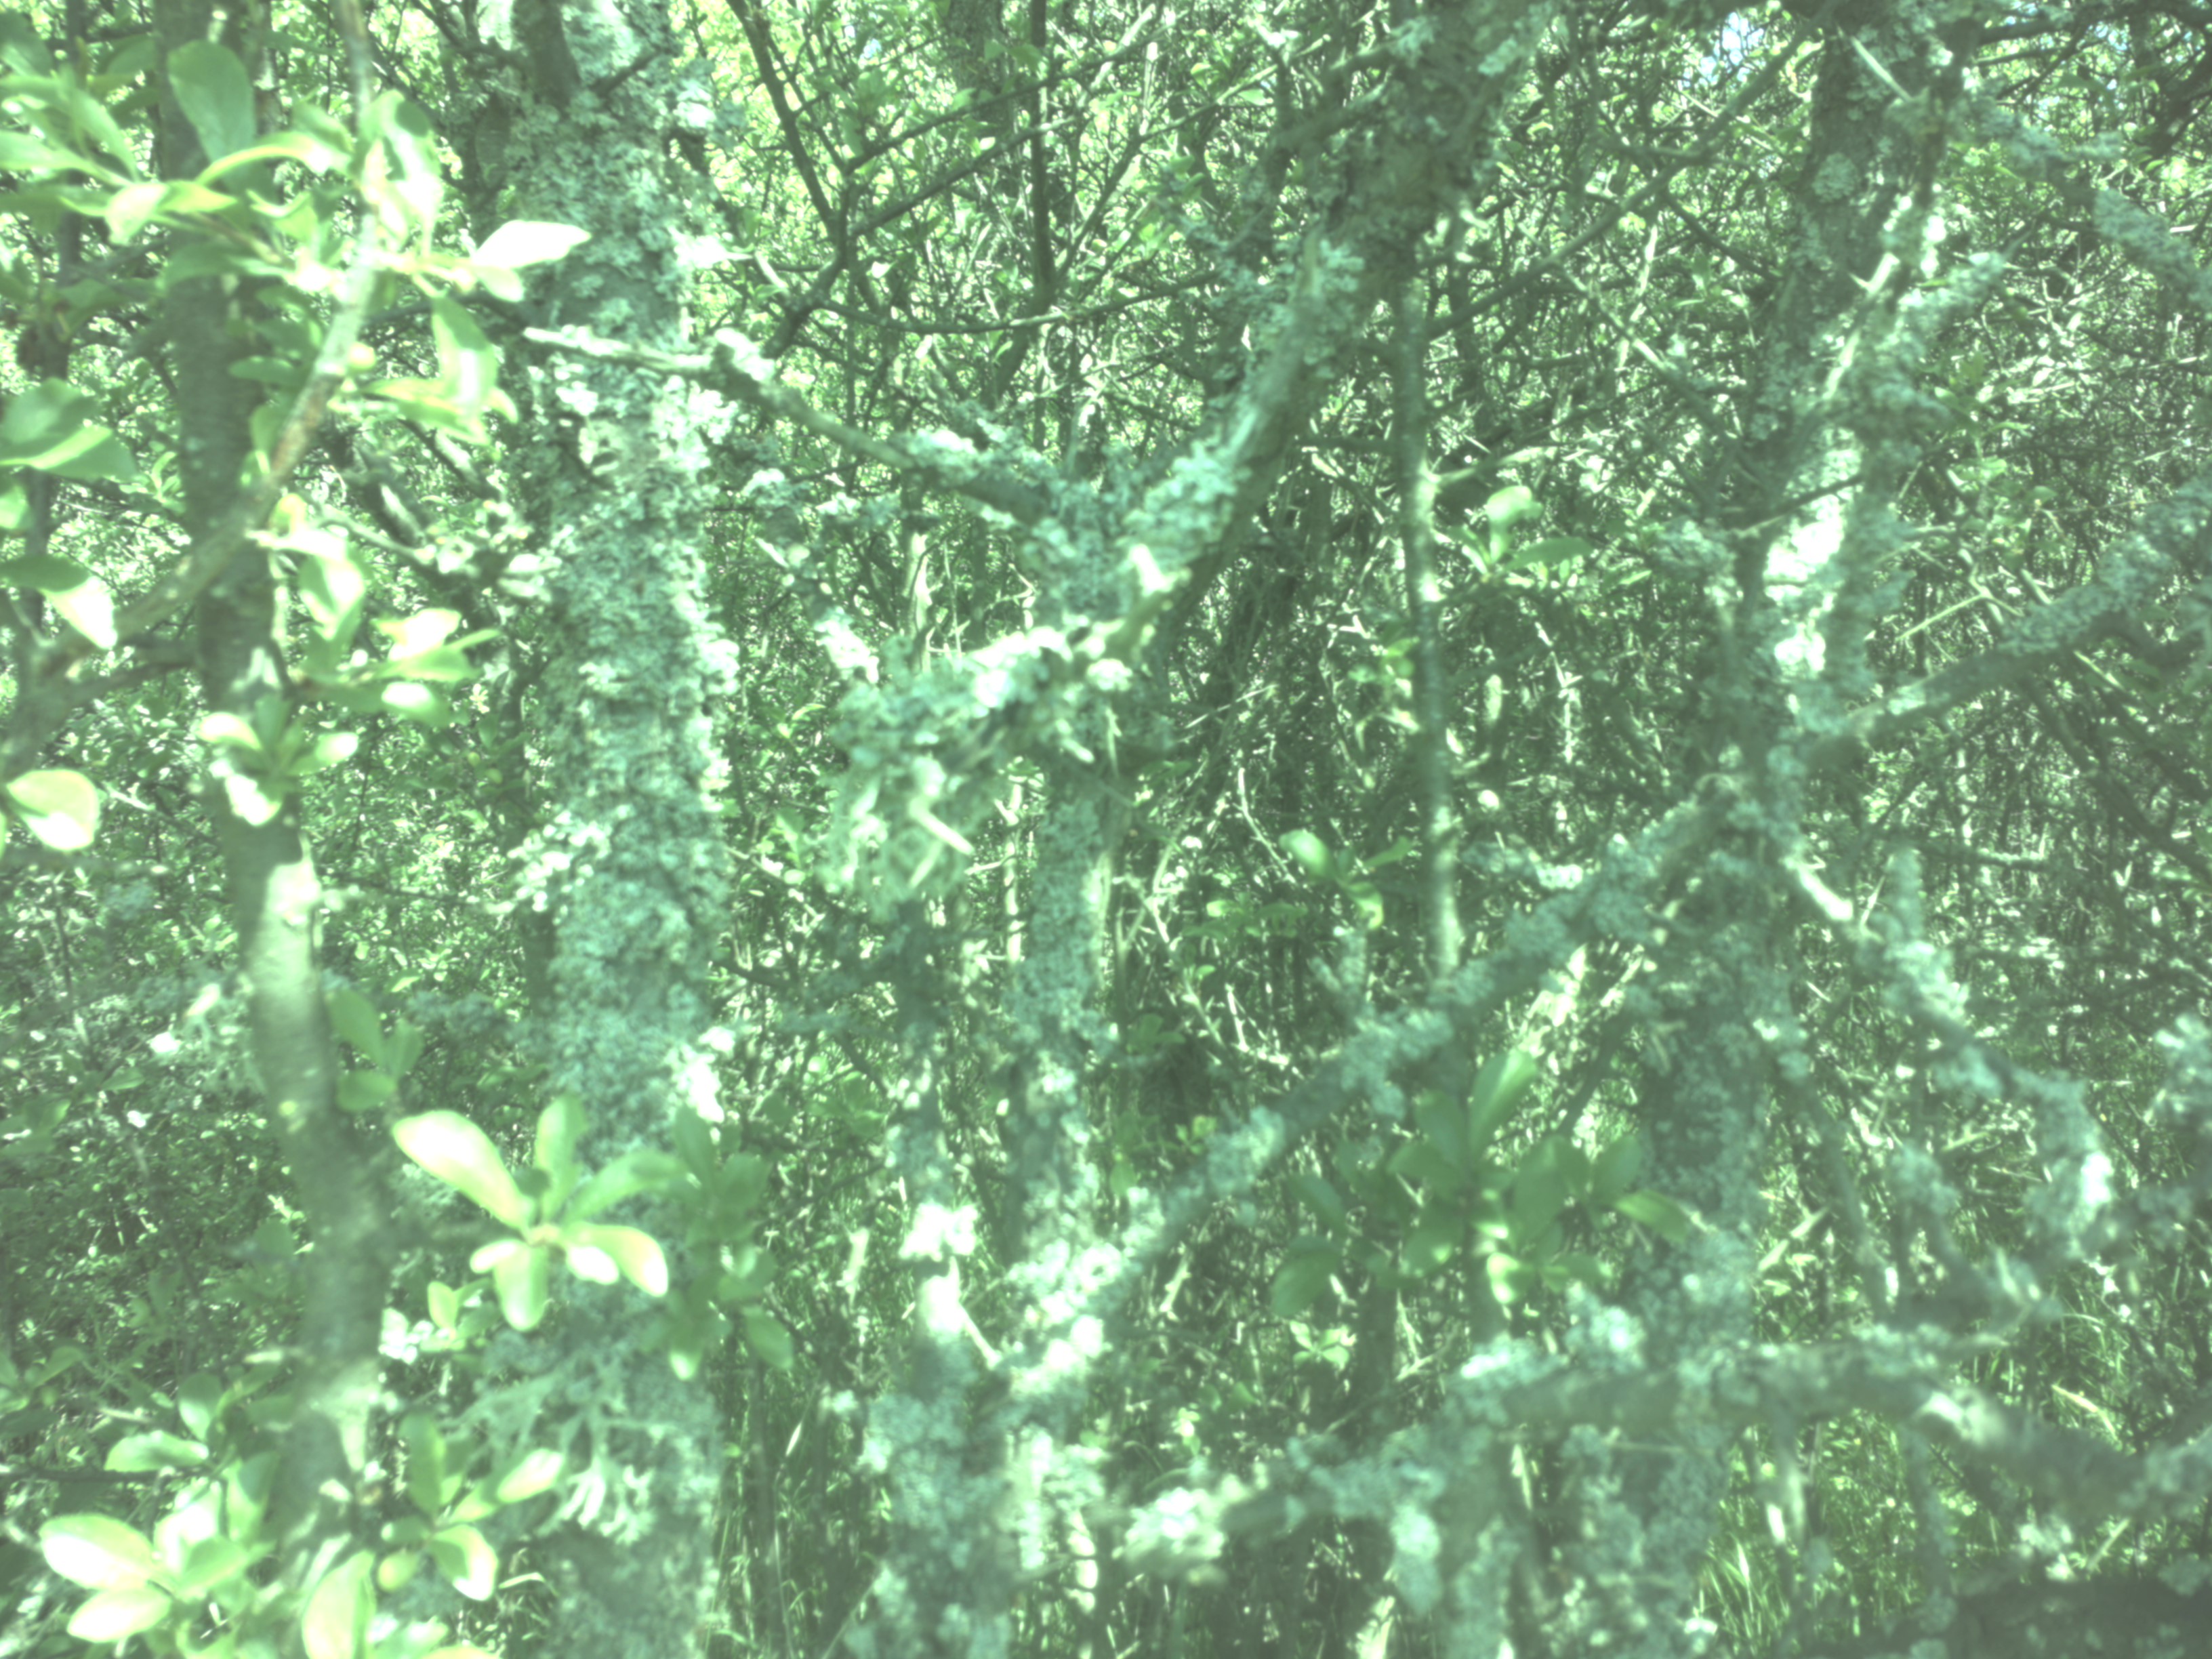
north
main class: Shrubland
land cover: Shrubland with sparse tree cover
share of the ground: > 75 %
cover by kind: shrubs 90 %, broadleaved forest trees 5 %, herbaceous plants 5 %
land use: Semi-natural and natural areas not in use
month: June
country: SE
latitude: 59.2844
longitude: 17.6675
